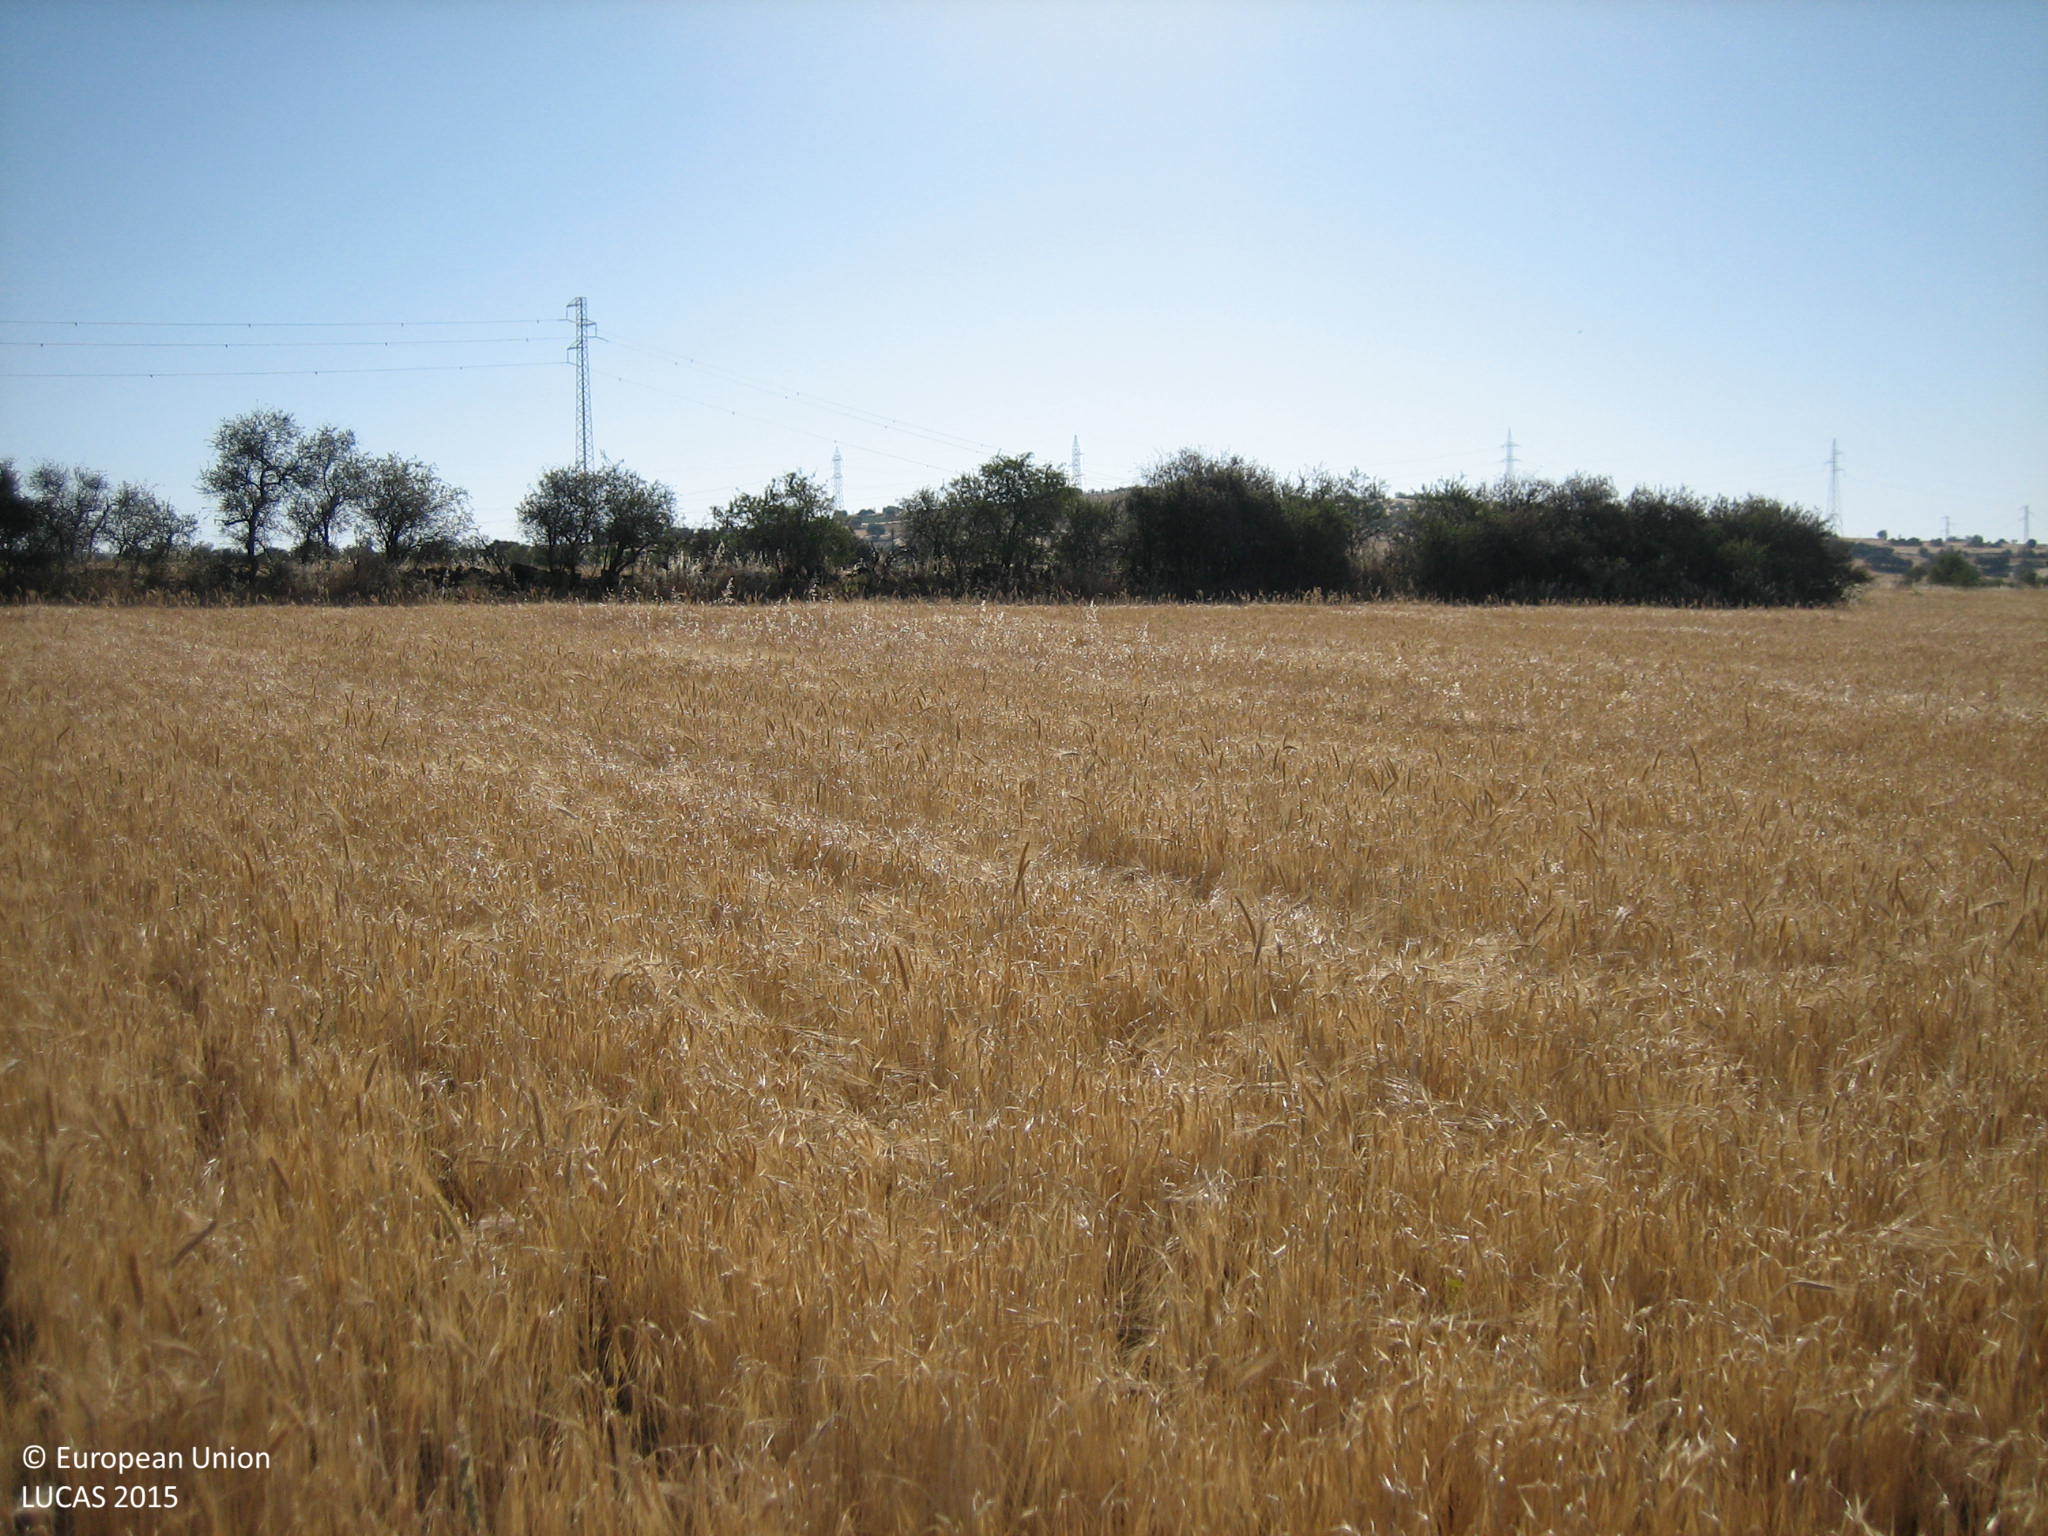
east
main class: Cropland
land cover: Barley
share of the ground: > 75 %
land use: Agriculture (excluding fallow land and kitchen gardens)
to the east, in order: Barley; Groves; Barley; Groves; Barley; Grass margins; Barley; Grass margins; Barley; Groves; Other bare soil
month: May
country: ES
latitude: 39.0050
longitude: -4.0994
